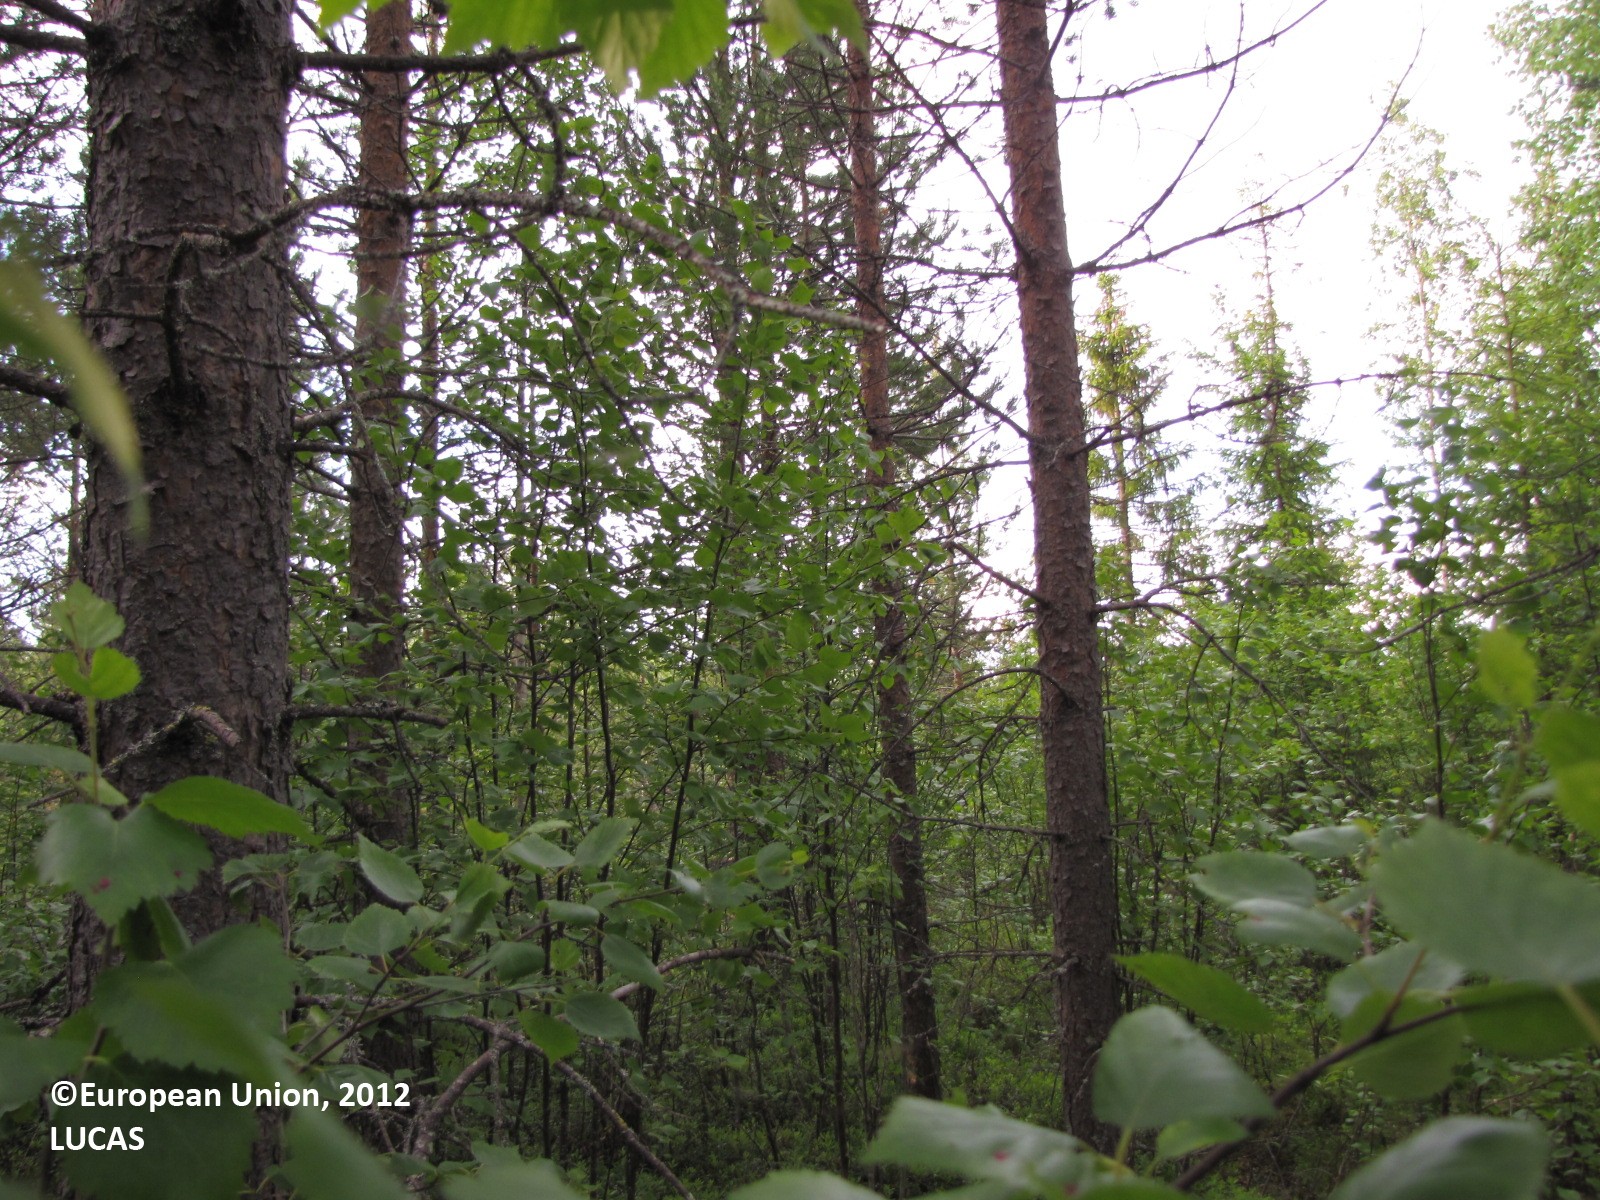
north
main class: Woodland
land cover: Pine dominated mixed woodland
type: boreal forest
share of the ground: 50 - 75 %
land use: Forestry
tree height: > 5 m
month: July
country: FI
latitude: 66.3900
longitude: 25.0705
